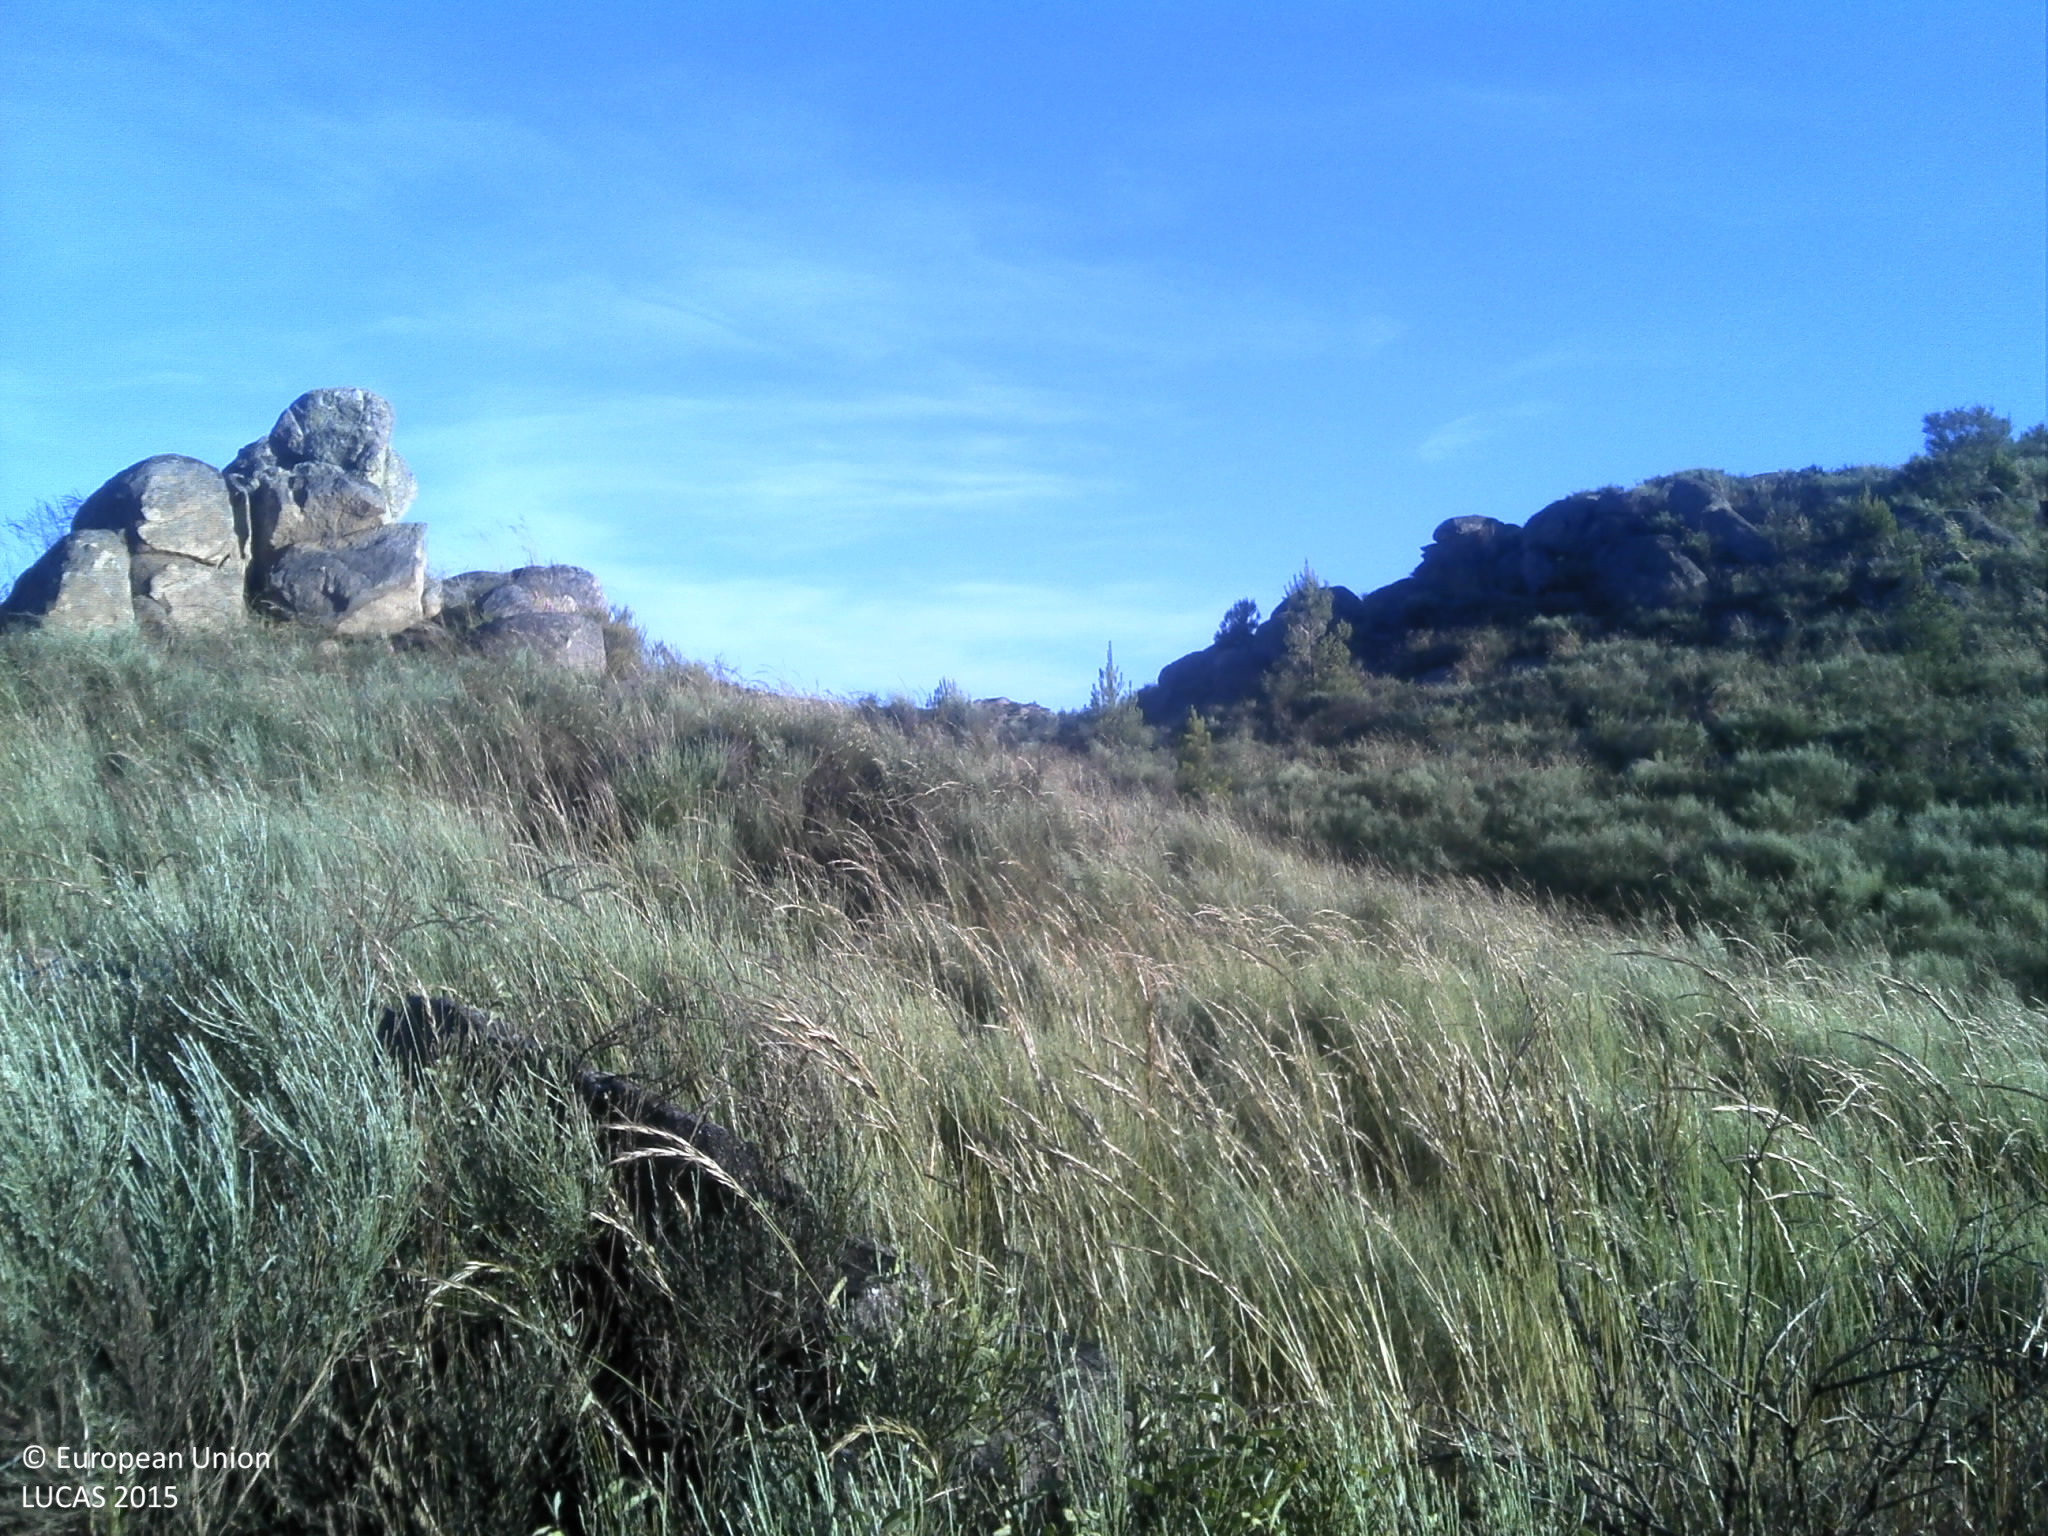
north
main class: Shrubland
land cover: Shrubland without tree cover
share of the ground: 50 - 75 %
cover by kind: shrubs 70 %, herbaceous plants 10 %, unconsolidated bare surface 10 %
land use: Agriculture (excluding fallow land and kitchen gardens)
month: May
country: PT
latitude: 40.5790
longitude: -7.5142
